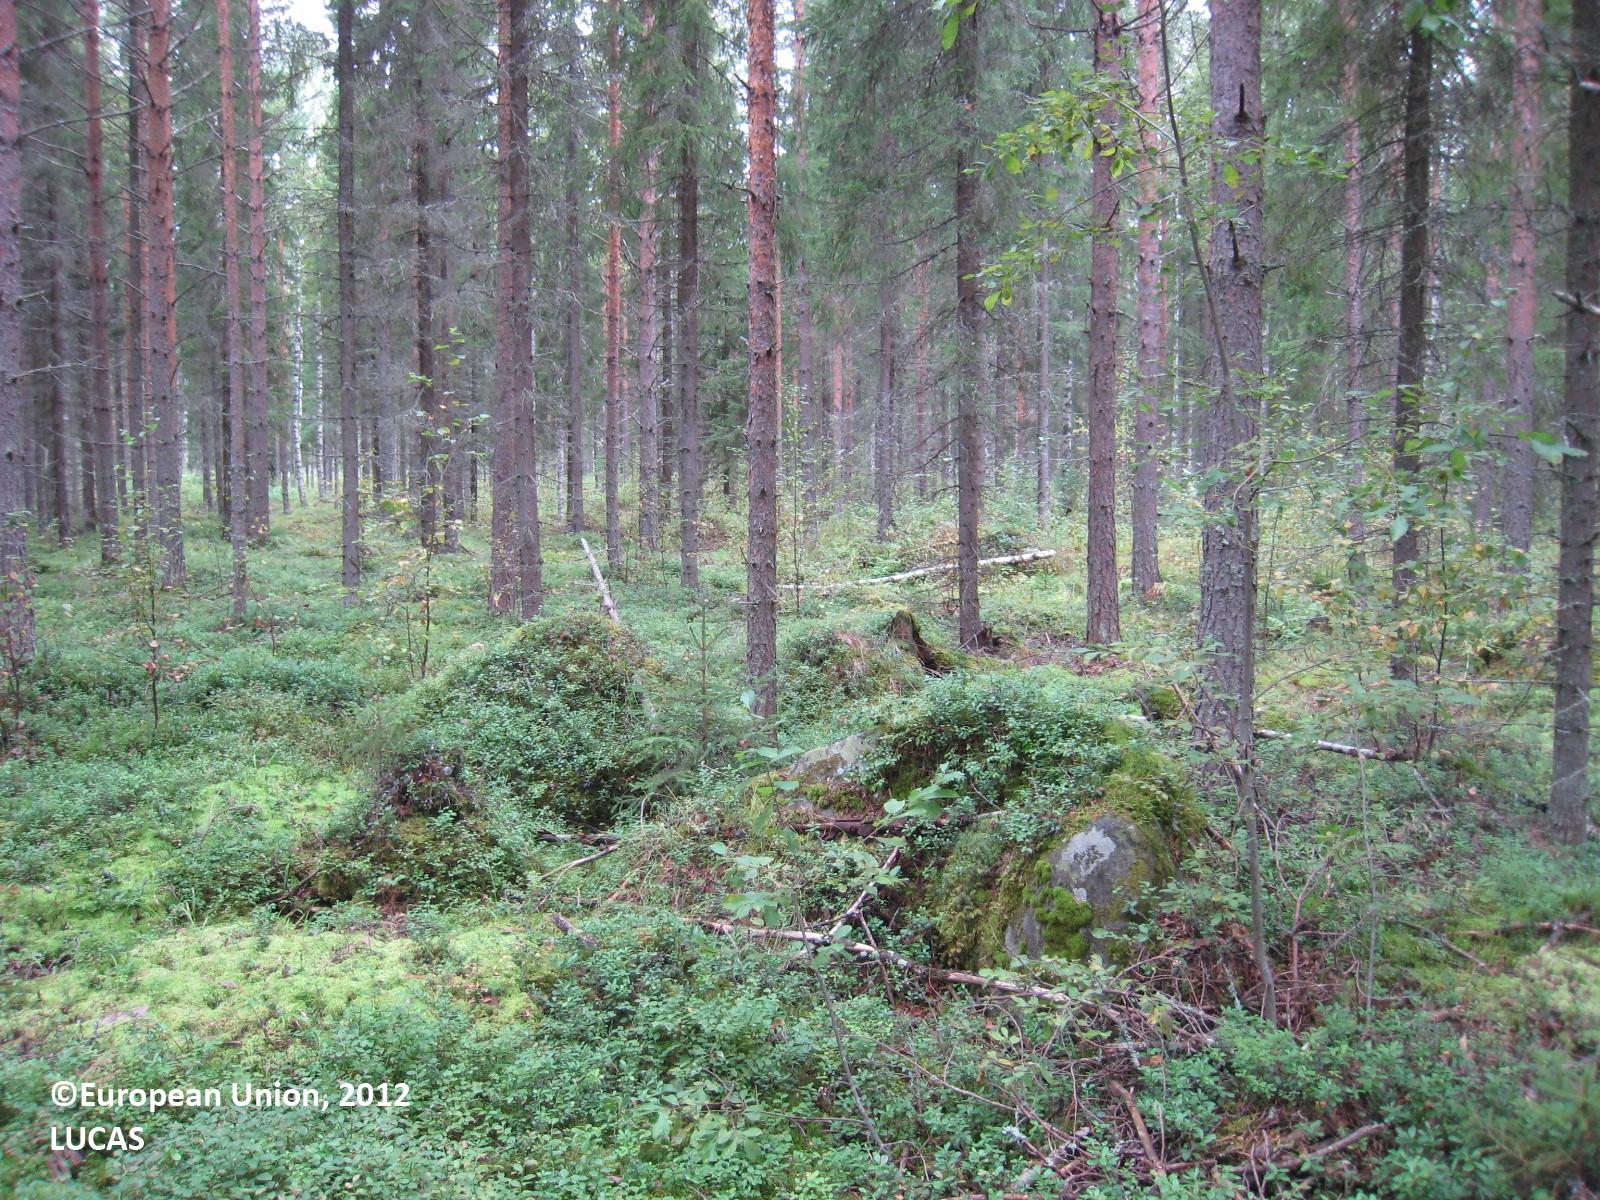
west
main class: Woodland
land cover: Other coniferous woodland
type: boreal forest
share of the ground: 50 - 75 %
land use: Forestry
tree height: > 5 m
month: August
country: FI
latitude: 62.1199
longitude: 27.1243
